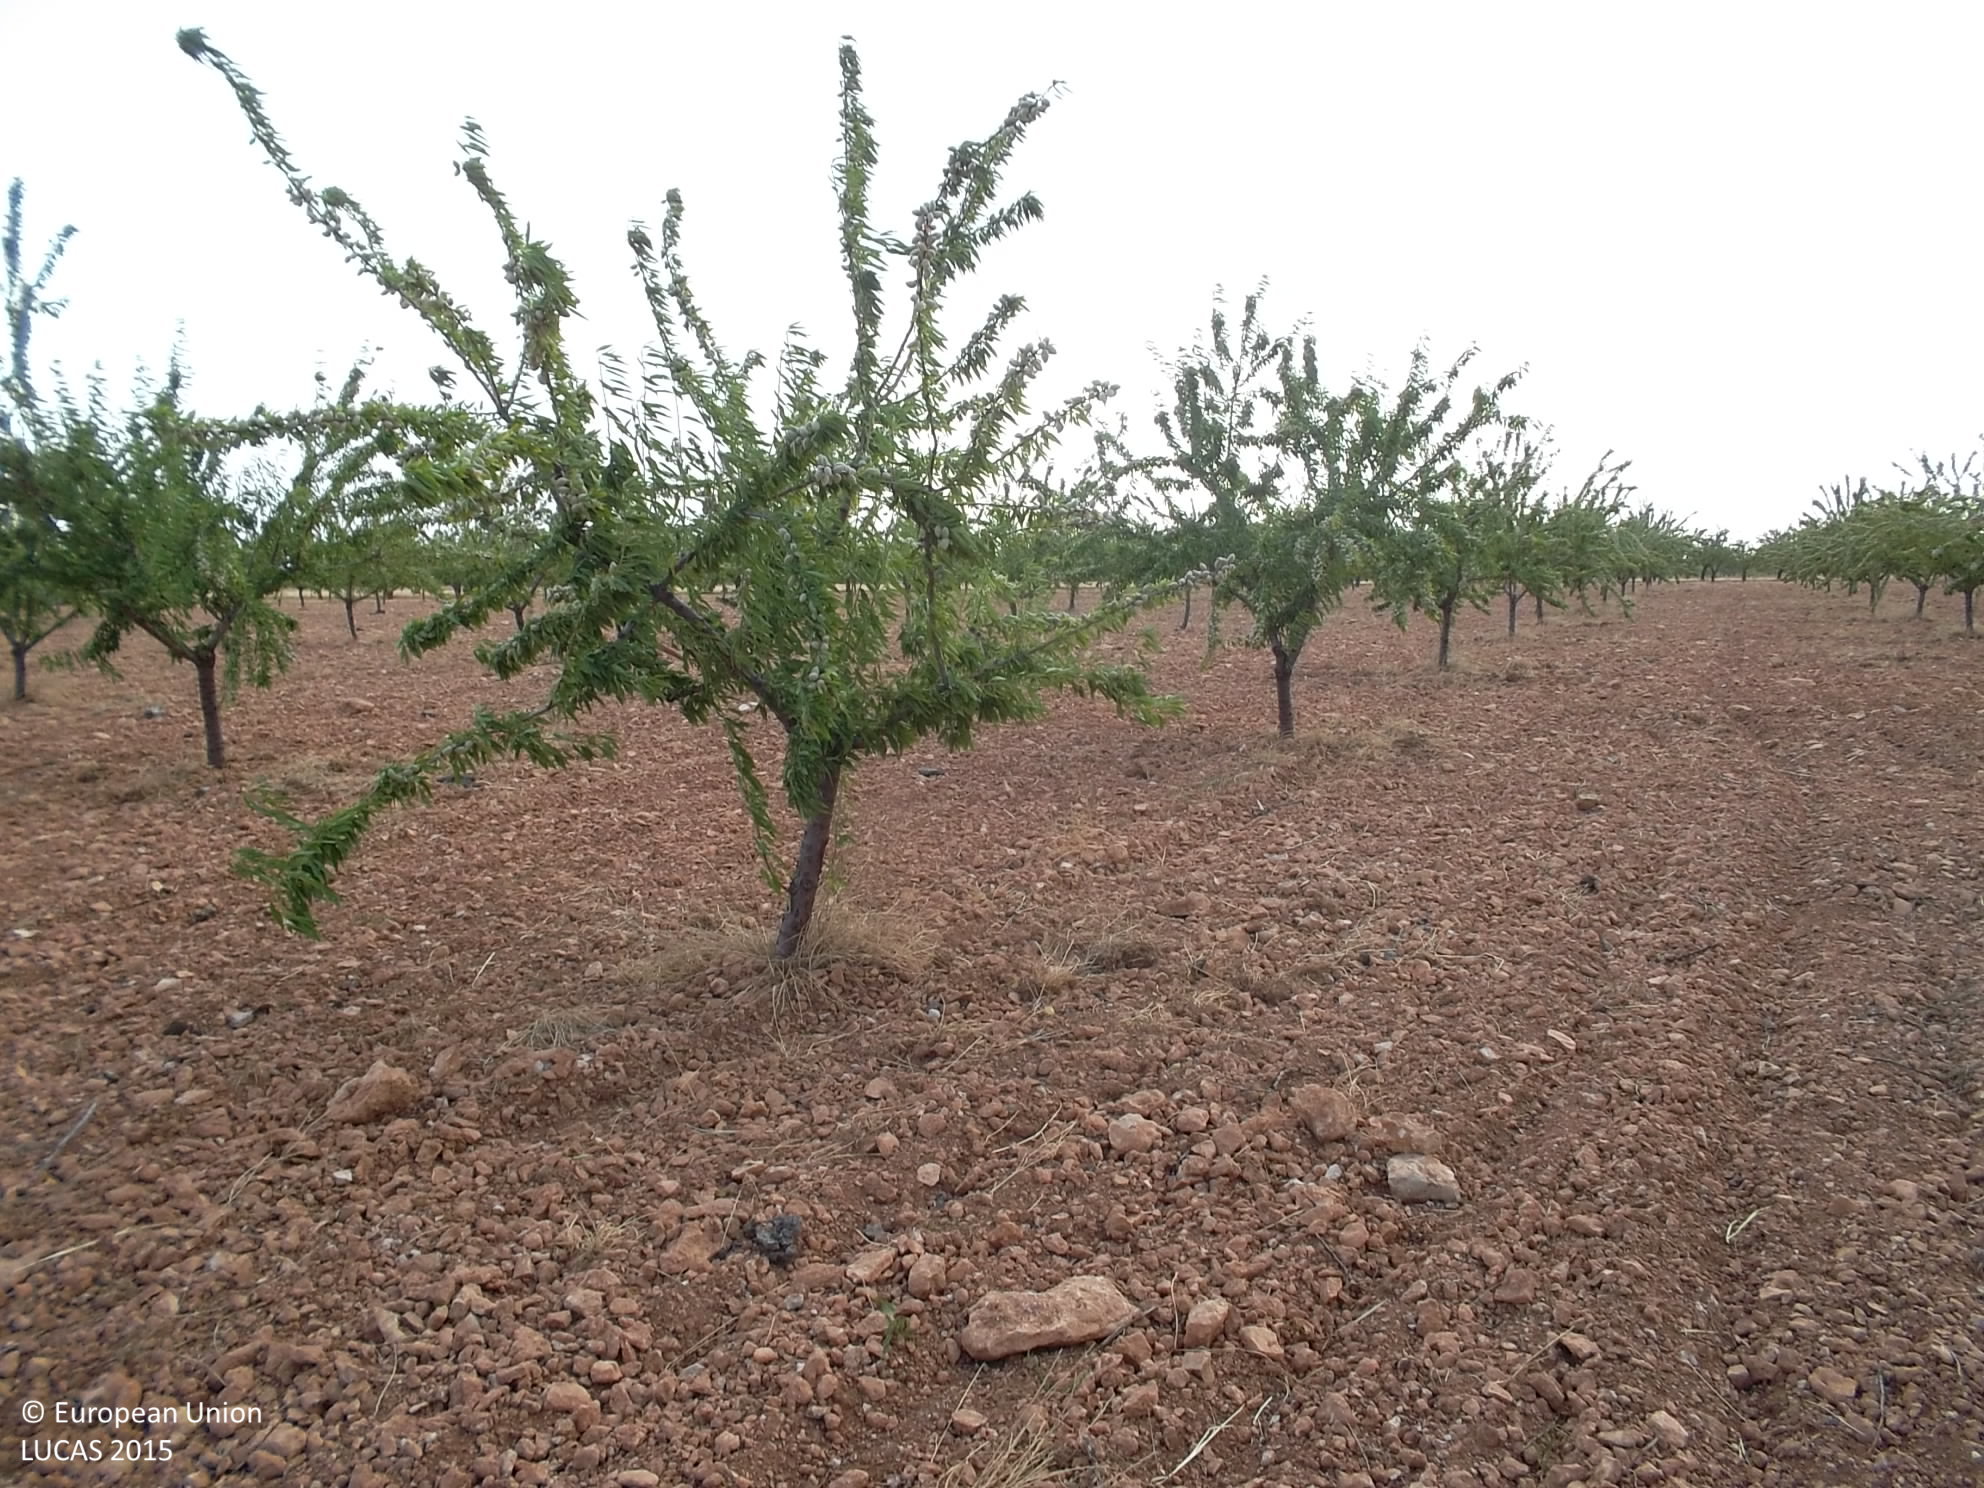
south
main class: Cropland
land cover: Nuts trees
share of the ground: 25 - 50 %
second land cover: Other bare soil
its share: > 75 %
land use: Agriculture (excluding fallow land and kitchen gardens)
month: July
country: ES
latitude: 37.7252
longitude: -2.7771
